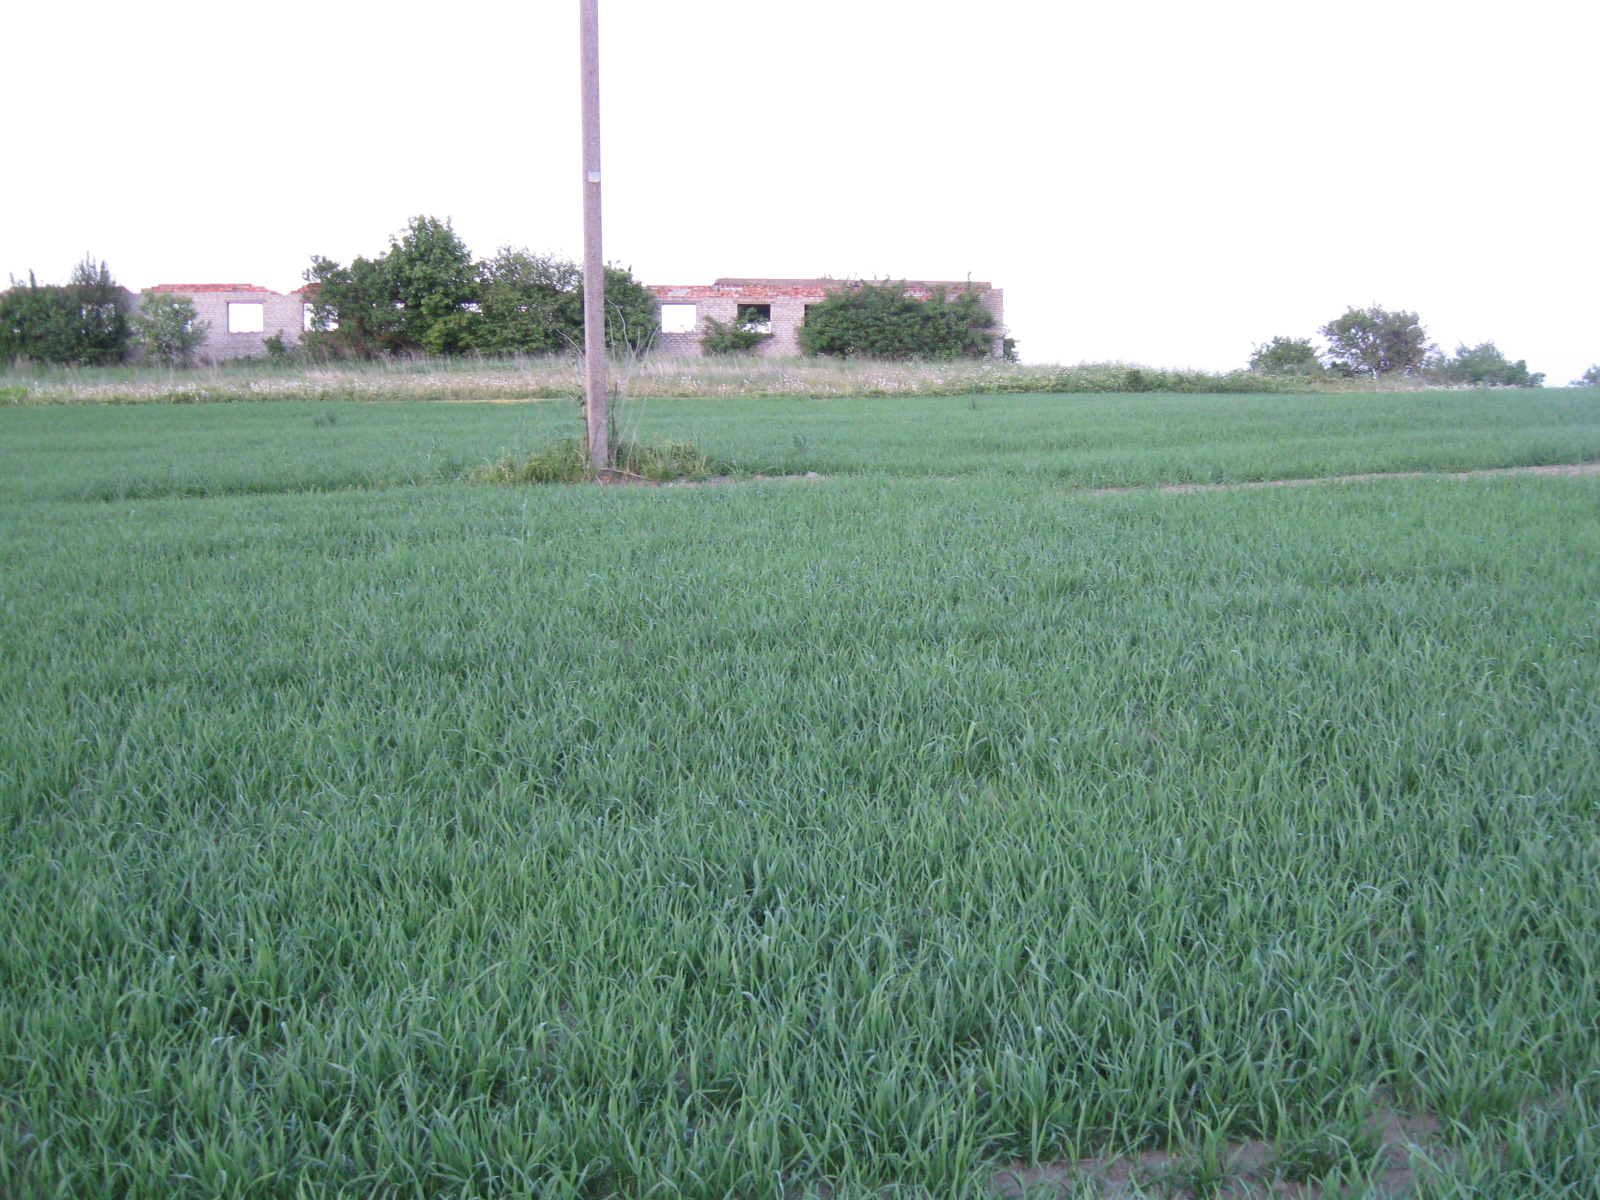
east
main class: Cropland
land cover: Common wheat
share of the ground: > 75 %
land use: Agriculture (excluding fallow land and kitchen gardens)
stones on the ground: < 10 %
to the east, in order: Common wheat; Electric lines; Common wheat; Spontaneously vegetated surfaces; Broadleaved woodland; Artificial constructions in urban areas; Grassland with sparse tree/shrub cover; Broadleaved woodland; Tracks; Grassland without tree/shrub cover; Broadleaved woodland
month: May
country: LT
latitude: 54.5306
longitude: 22.7235
